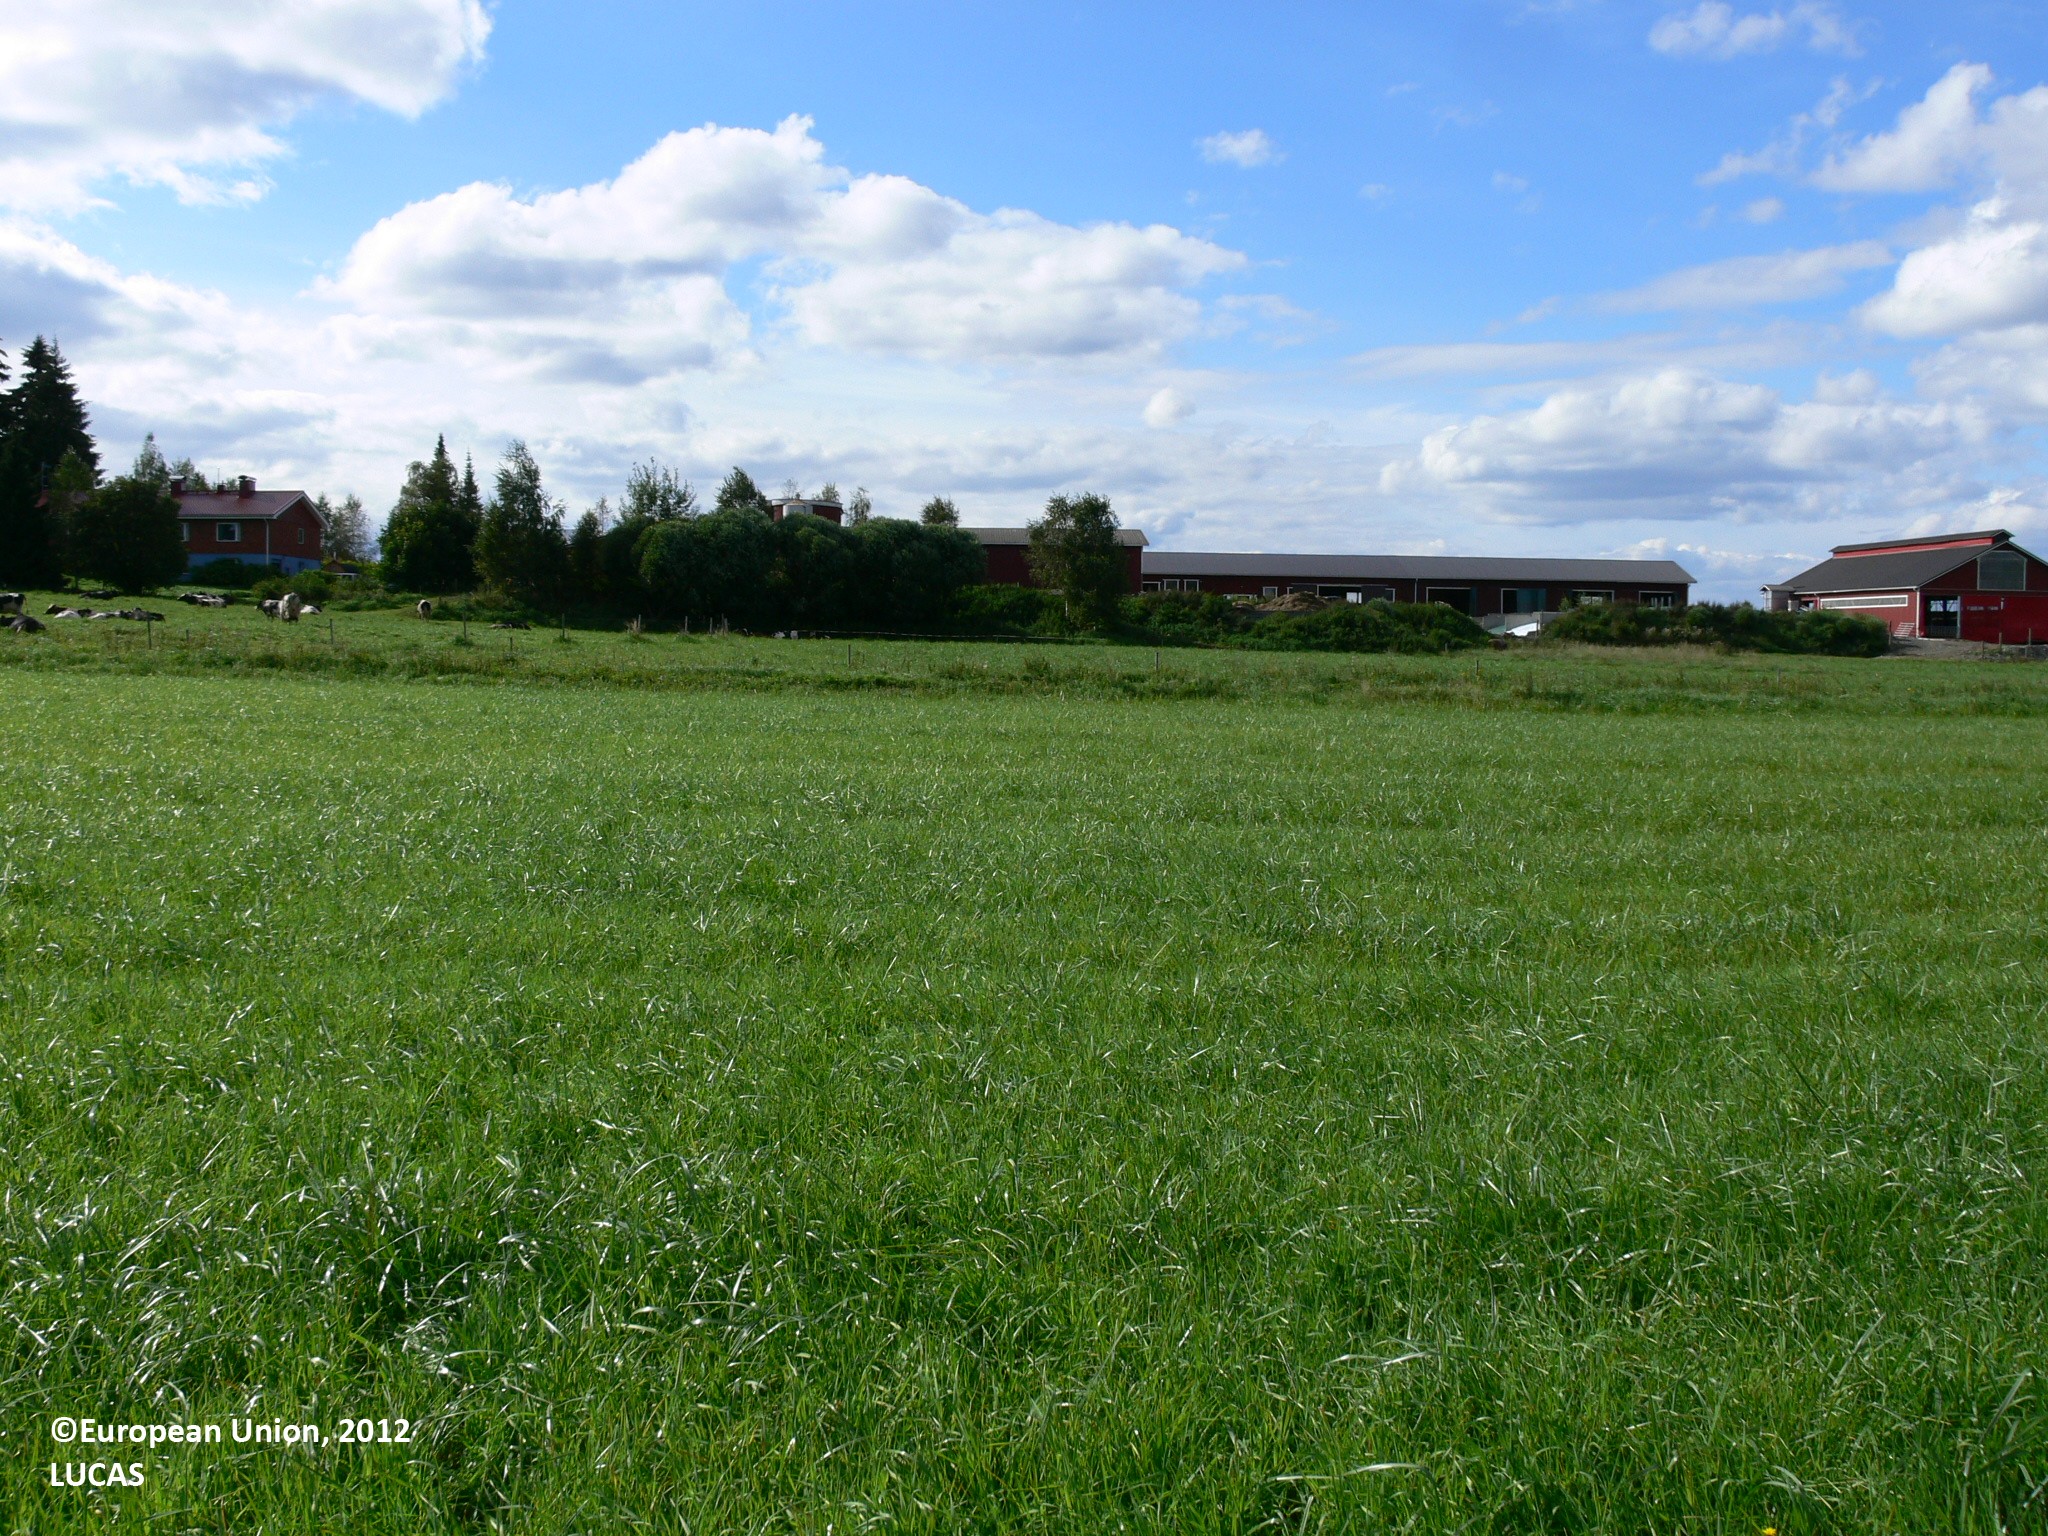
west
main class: Cropland
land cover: Temporary grasslands
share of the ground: > 75 %
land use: Agriculture (excluding fallow land and kitchen gardens)
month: August
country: FI
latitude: 62.0742
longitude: 30.2392
